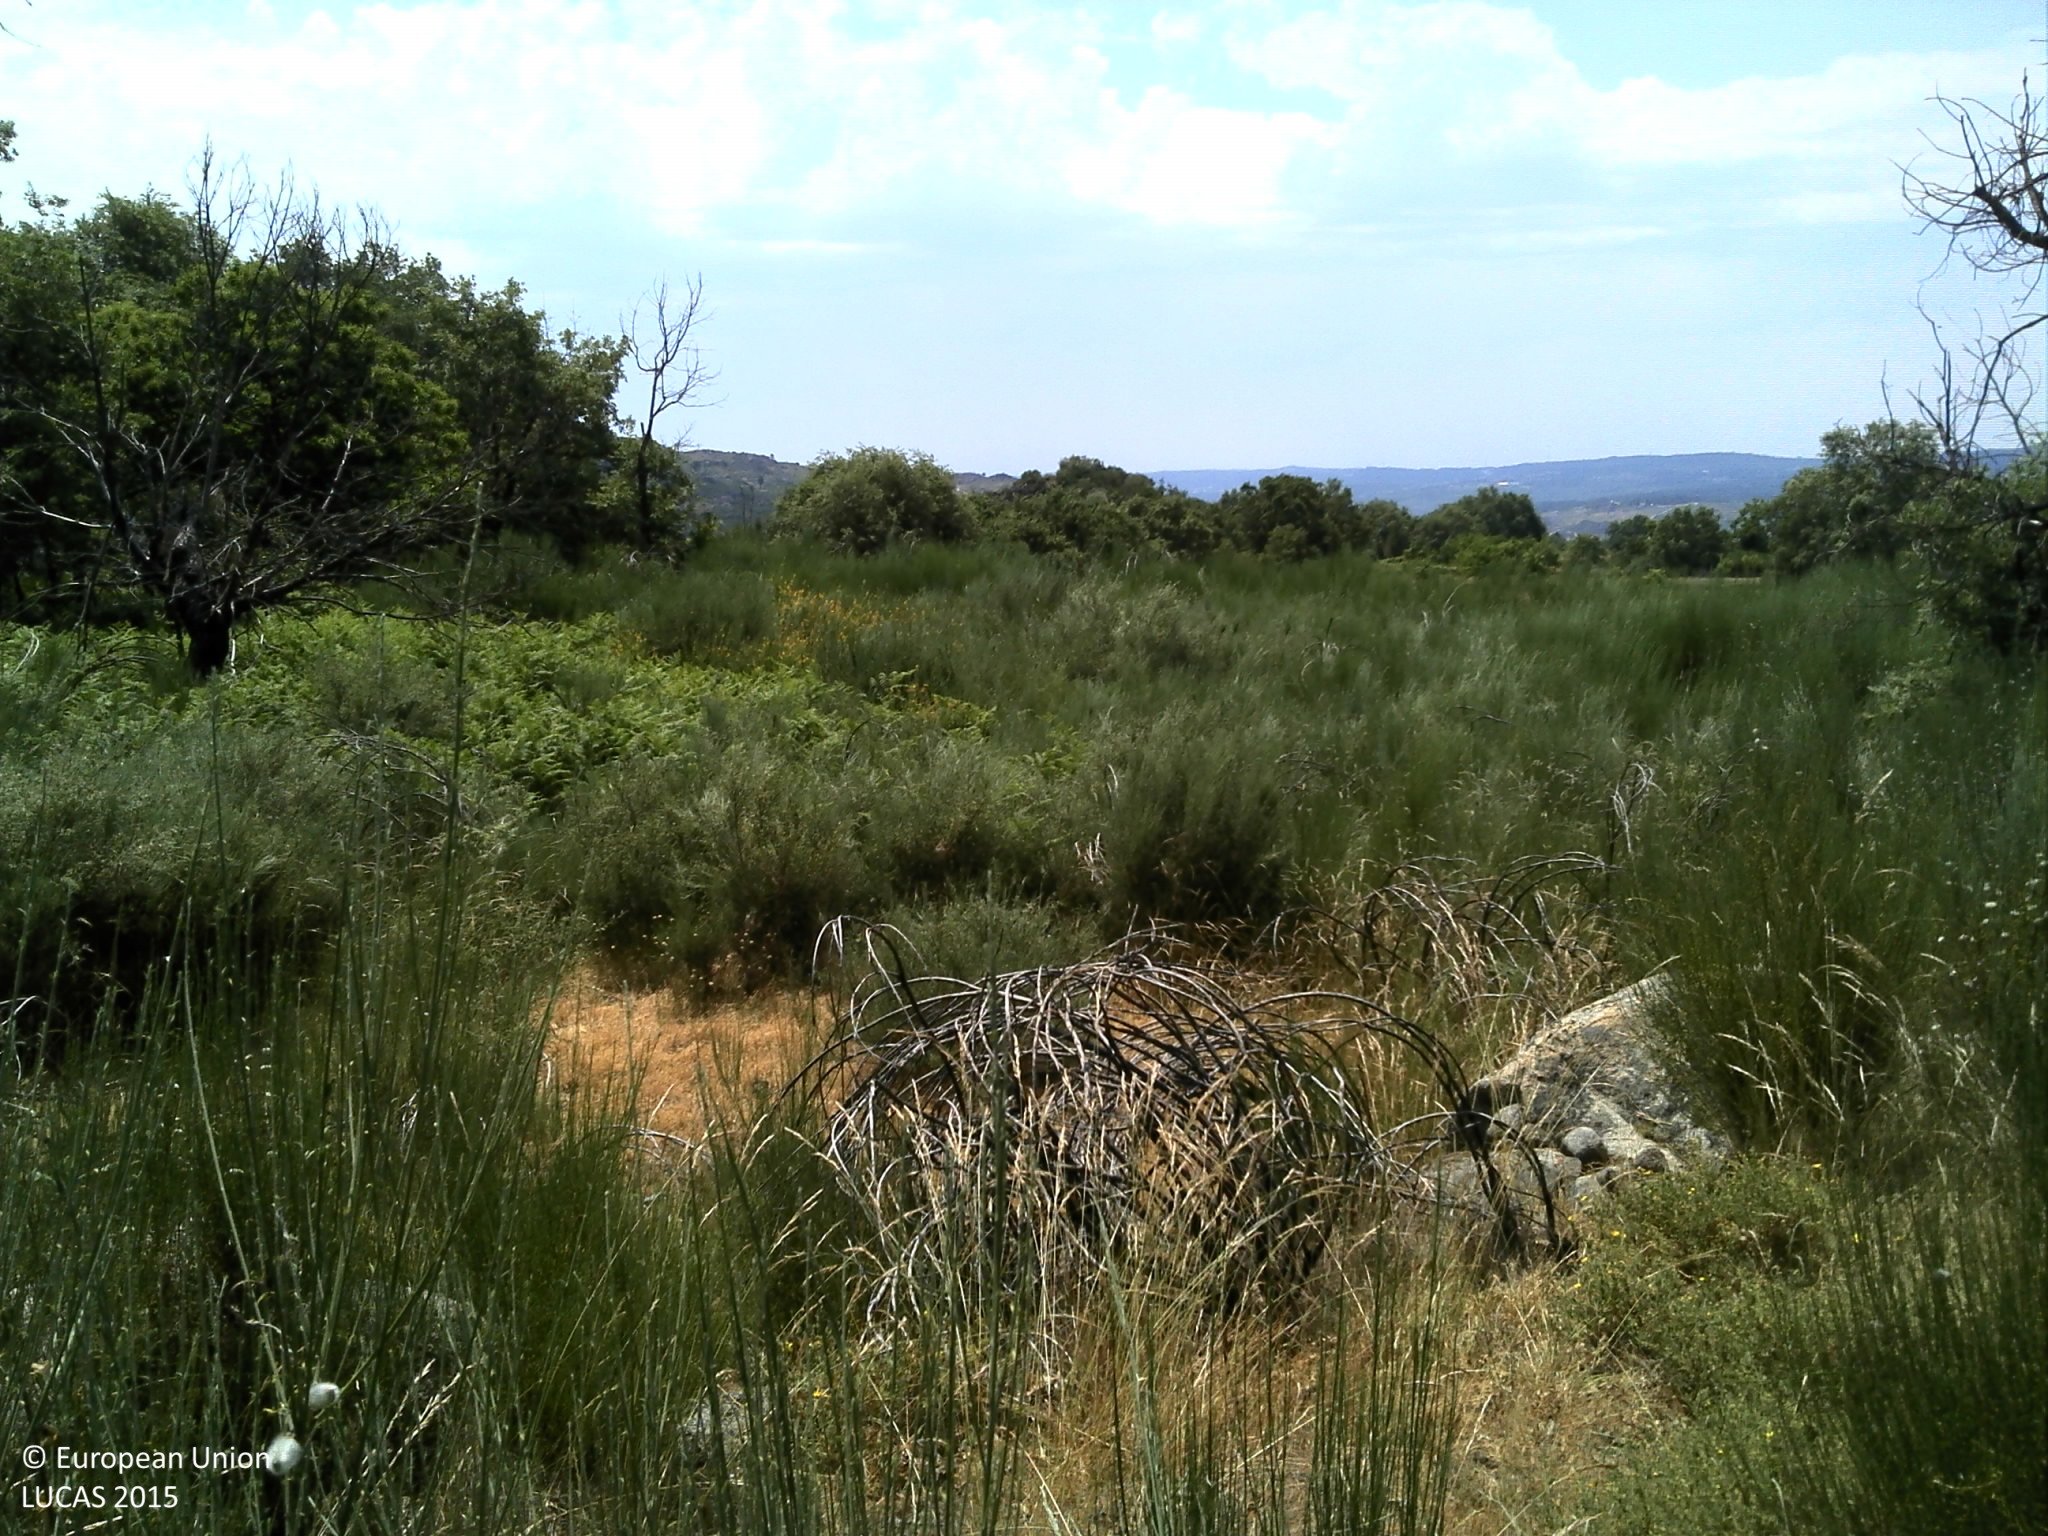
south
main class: Shrubland
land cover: Shrubland with sparse tree cover
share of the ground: > 75 %
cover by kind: shrubs 80 %, herbaceous plants 10 %, broadleaved forest trees 5 %, consolidated bare surface 5 %
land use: Semi-natural and natural areas not in use
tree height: > 5 m
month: June
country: PT
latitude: 41.4325
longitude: -7.5884
